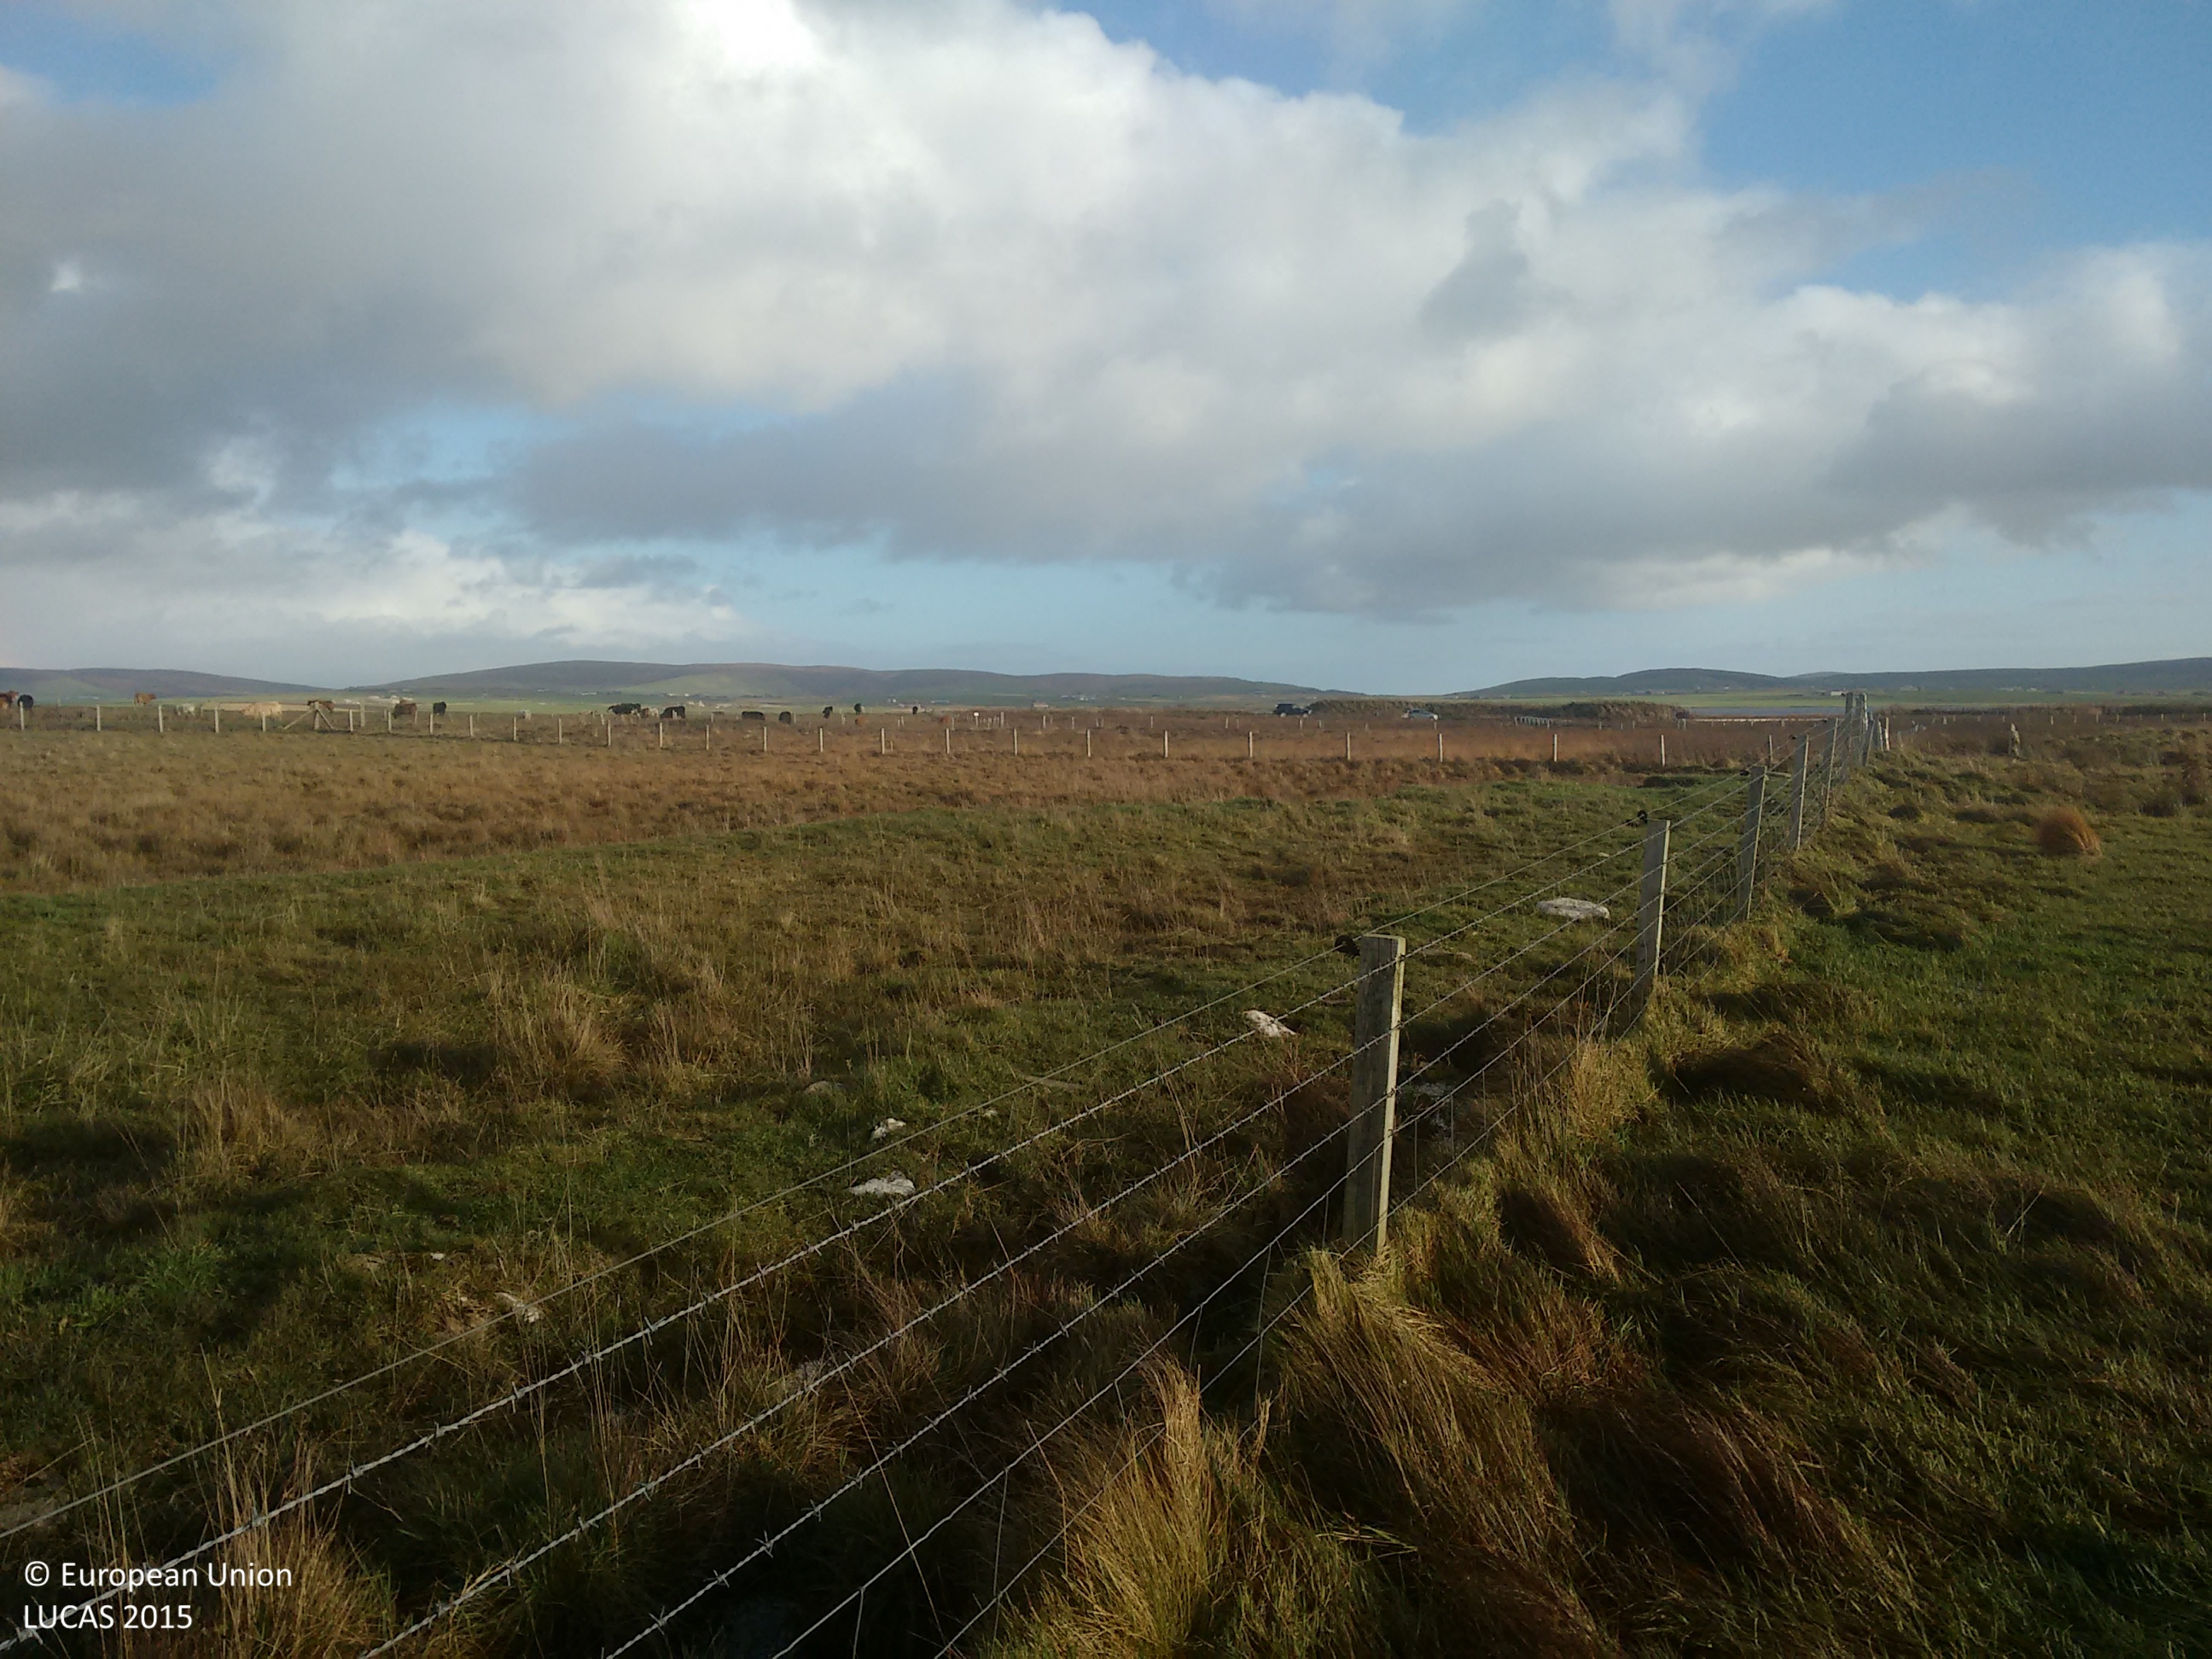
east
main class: Grassland
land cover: Grassland without tree/shrub cover
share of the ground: > 75 %
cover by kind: herbaceous plants 100 %
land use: Agriculture (excluding fallow land and kitchen gardens)
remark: Temporary flooded
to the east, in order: Grassland without tree/shrub cover; Fences; Inland marshes; Shrubland without tree cover; Fences; Ditches and canals; Paved roads, cycling and walking lanes; Grass margins; Inland marshes; Grassland without tree/shrub cover; Artificial constructions in urban areas
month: November
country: GB
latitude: 59.0046
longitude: -3.2357
